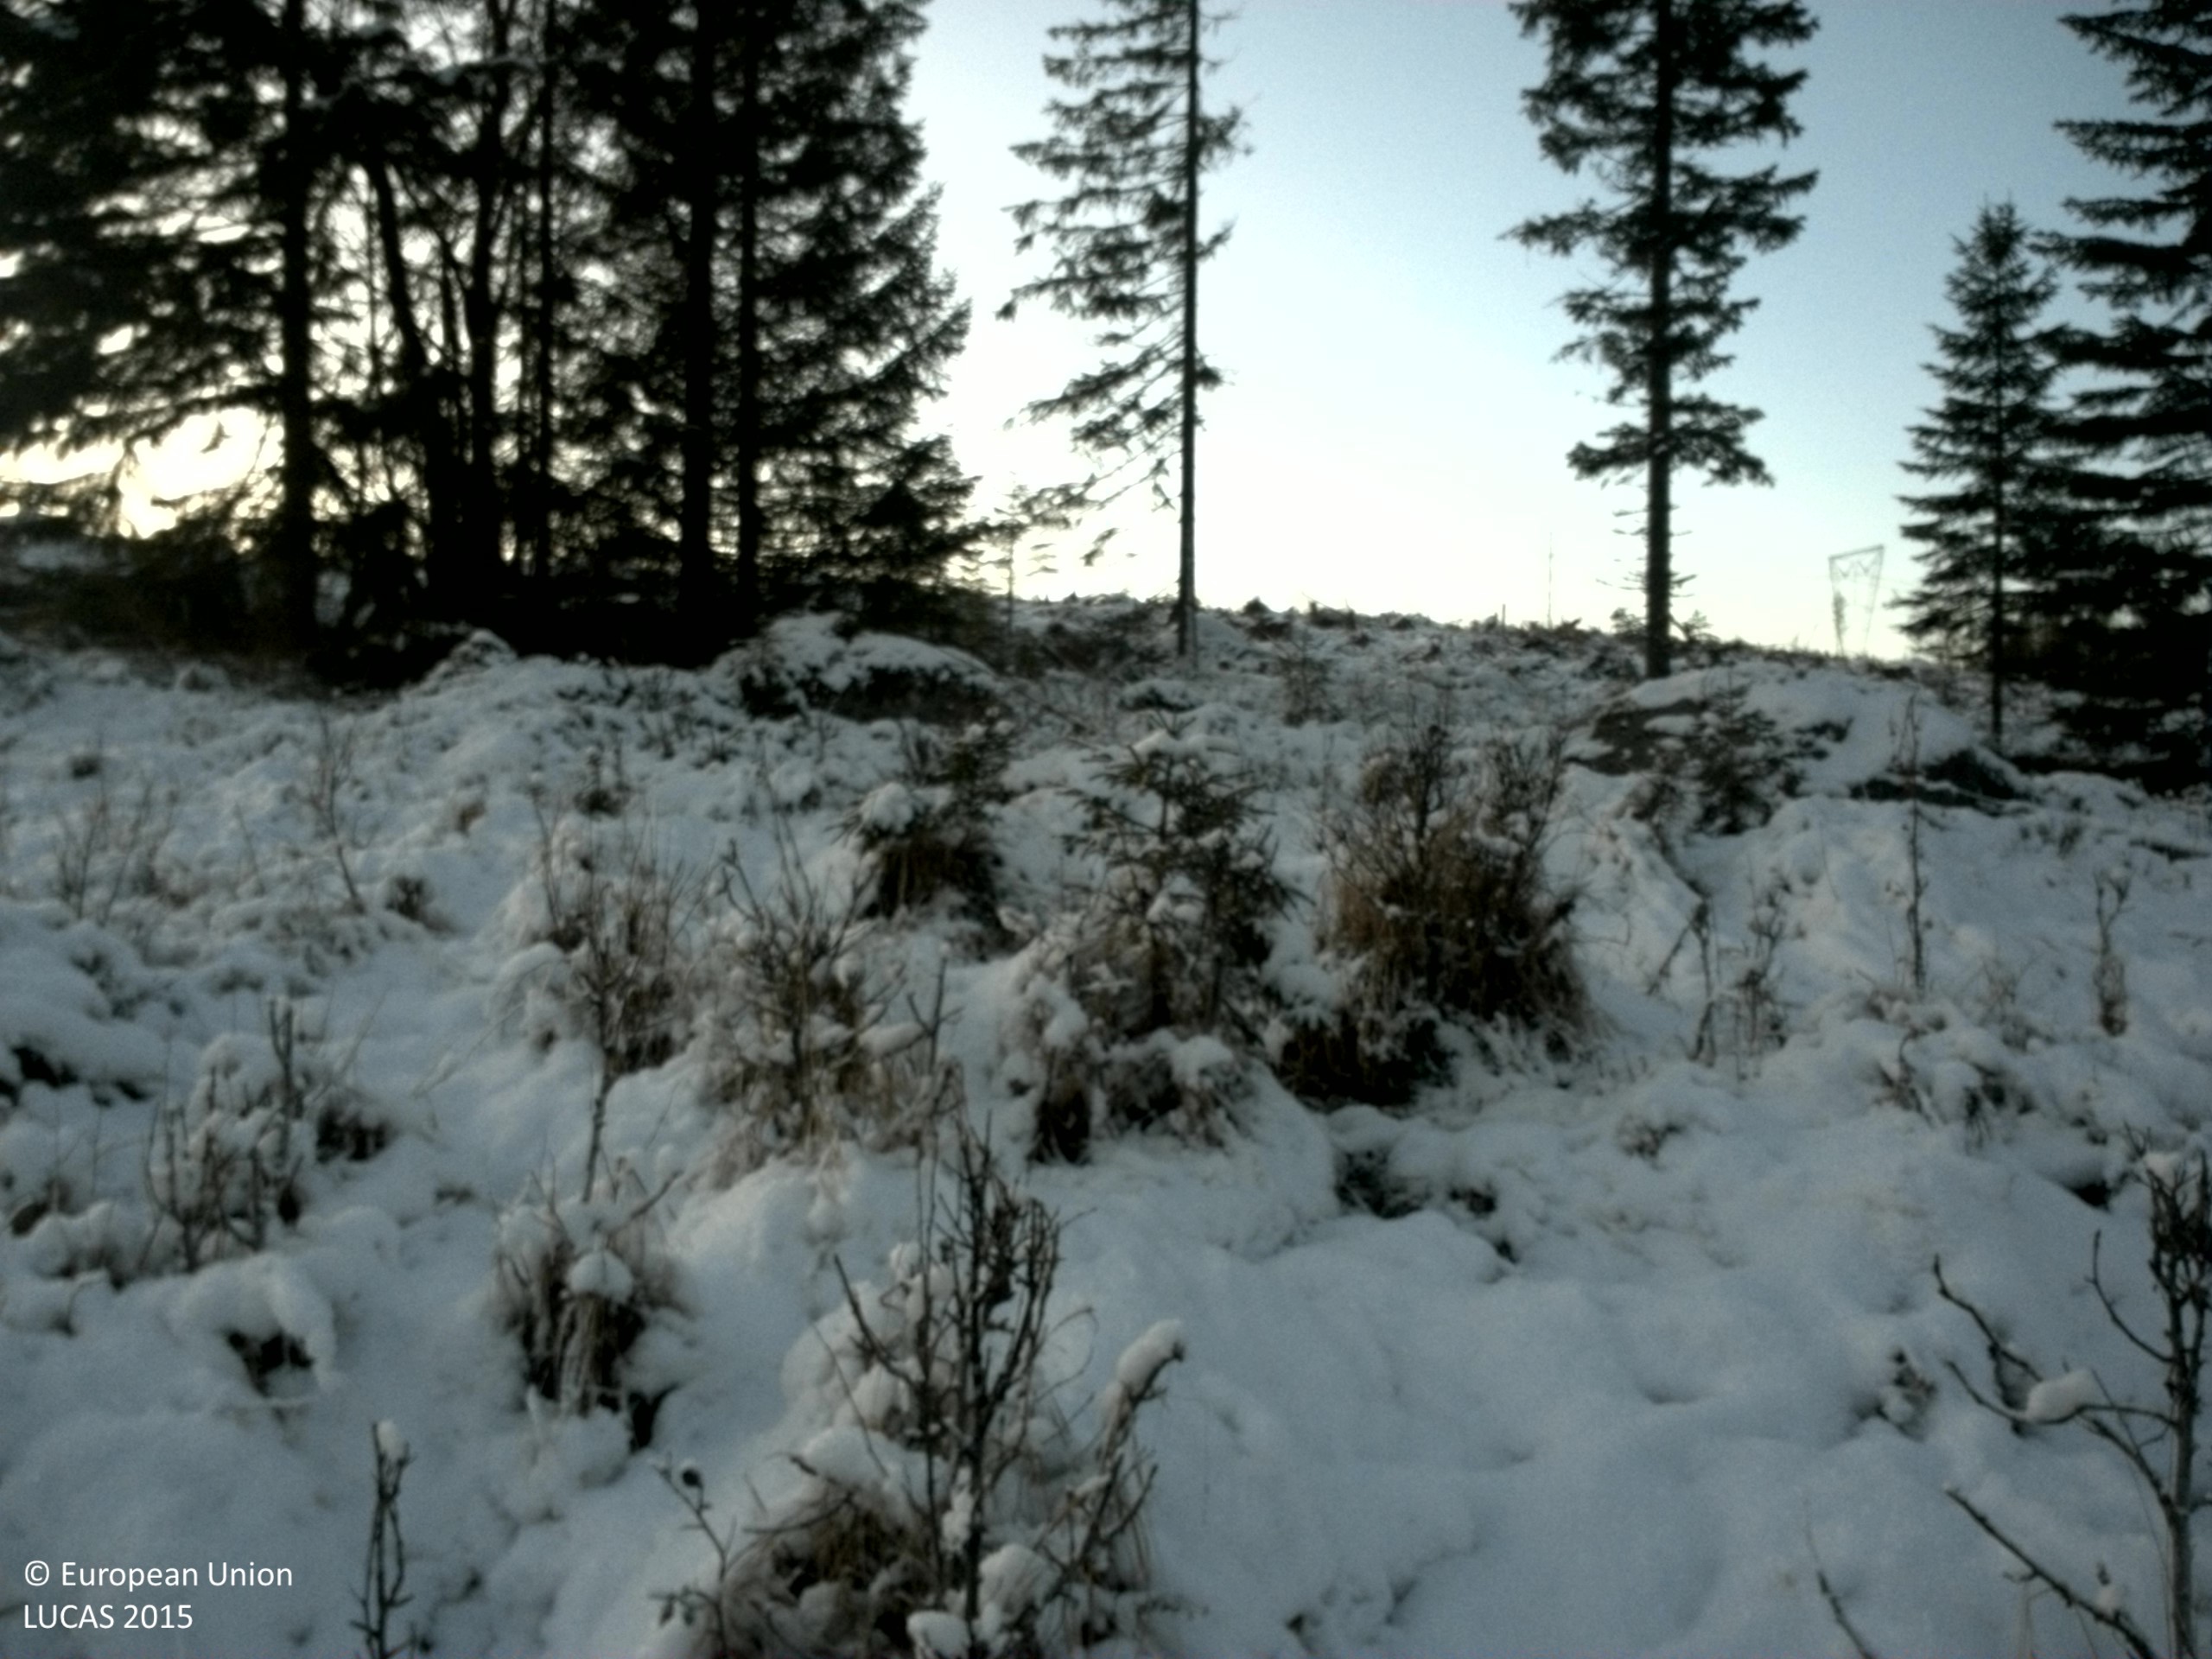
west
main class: Woodland
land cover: Spruce dominated mixed woodland
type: boreal forest
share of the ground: 10 - 25 %
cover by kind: herbaceous plants 35 %, shrubs 25 %, broadleaved forest trees 15 %, lichens and mosses 15 %, coniferous forest trees 5 %
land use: Electricity, gas and thermal power distribution
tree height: < 5 m
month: November
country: SE
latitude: 62.0417
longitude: 15.5074
